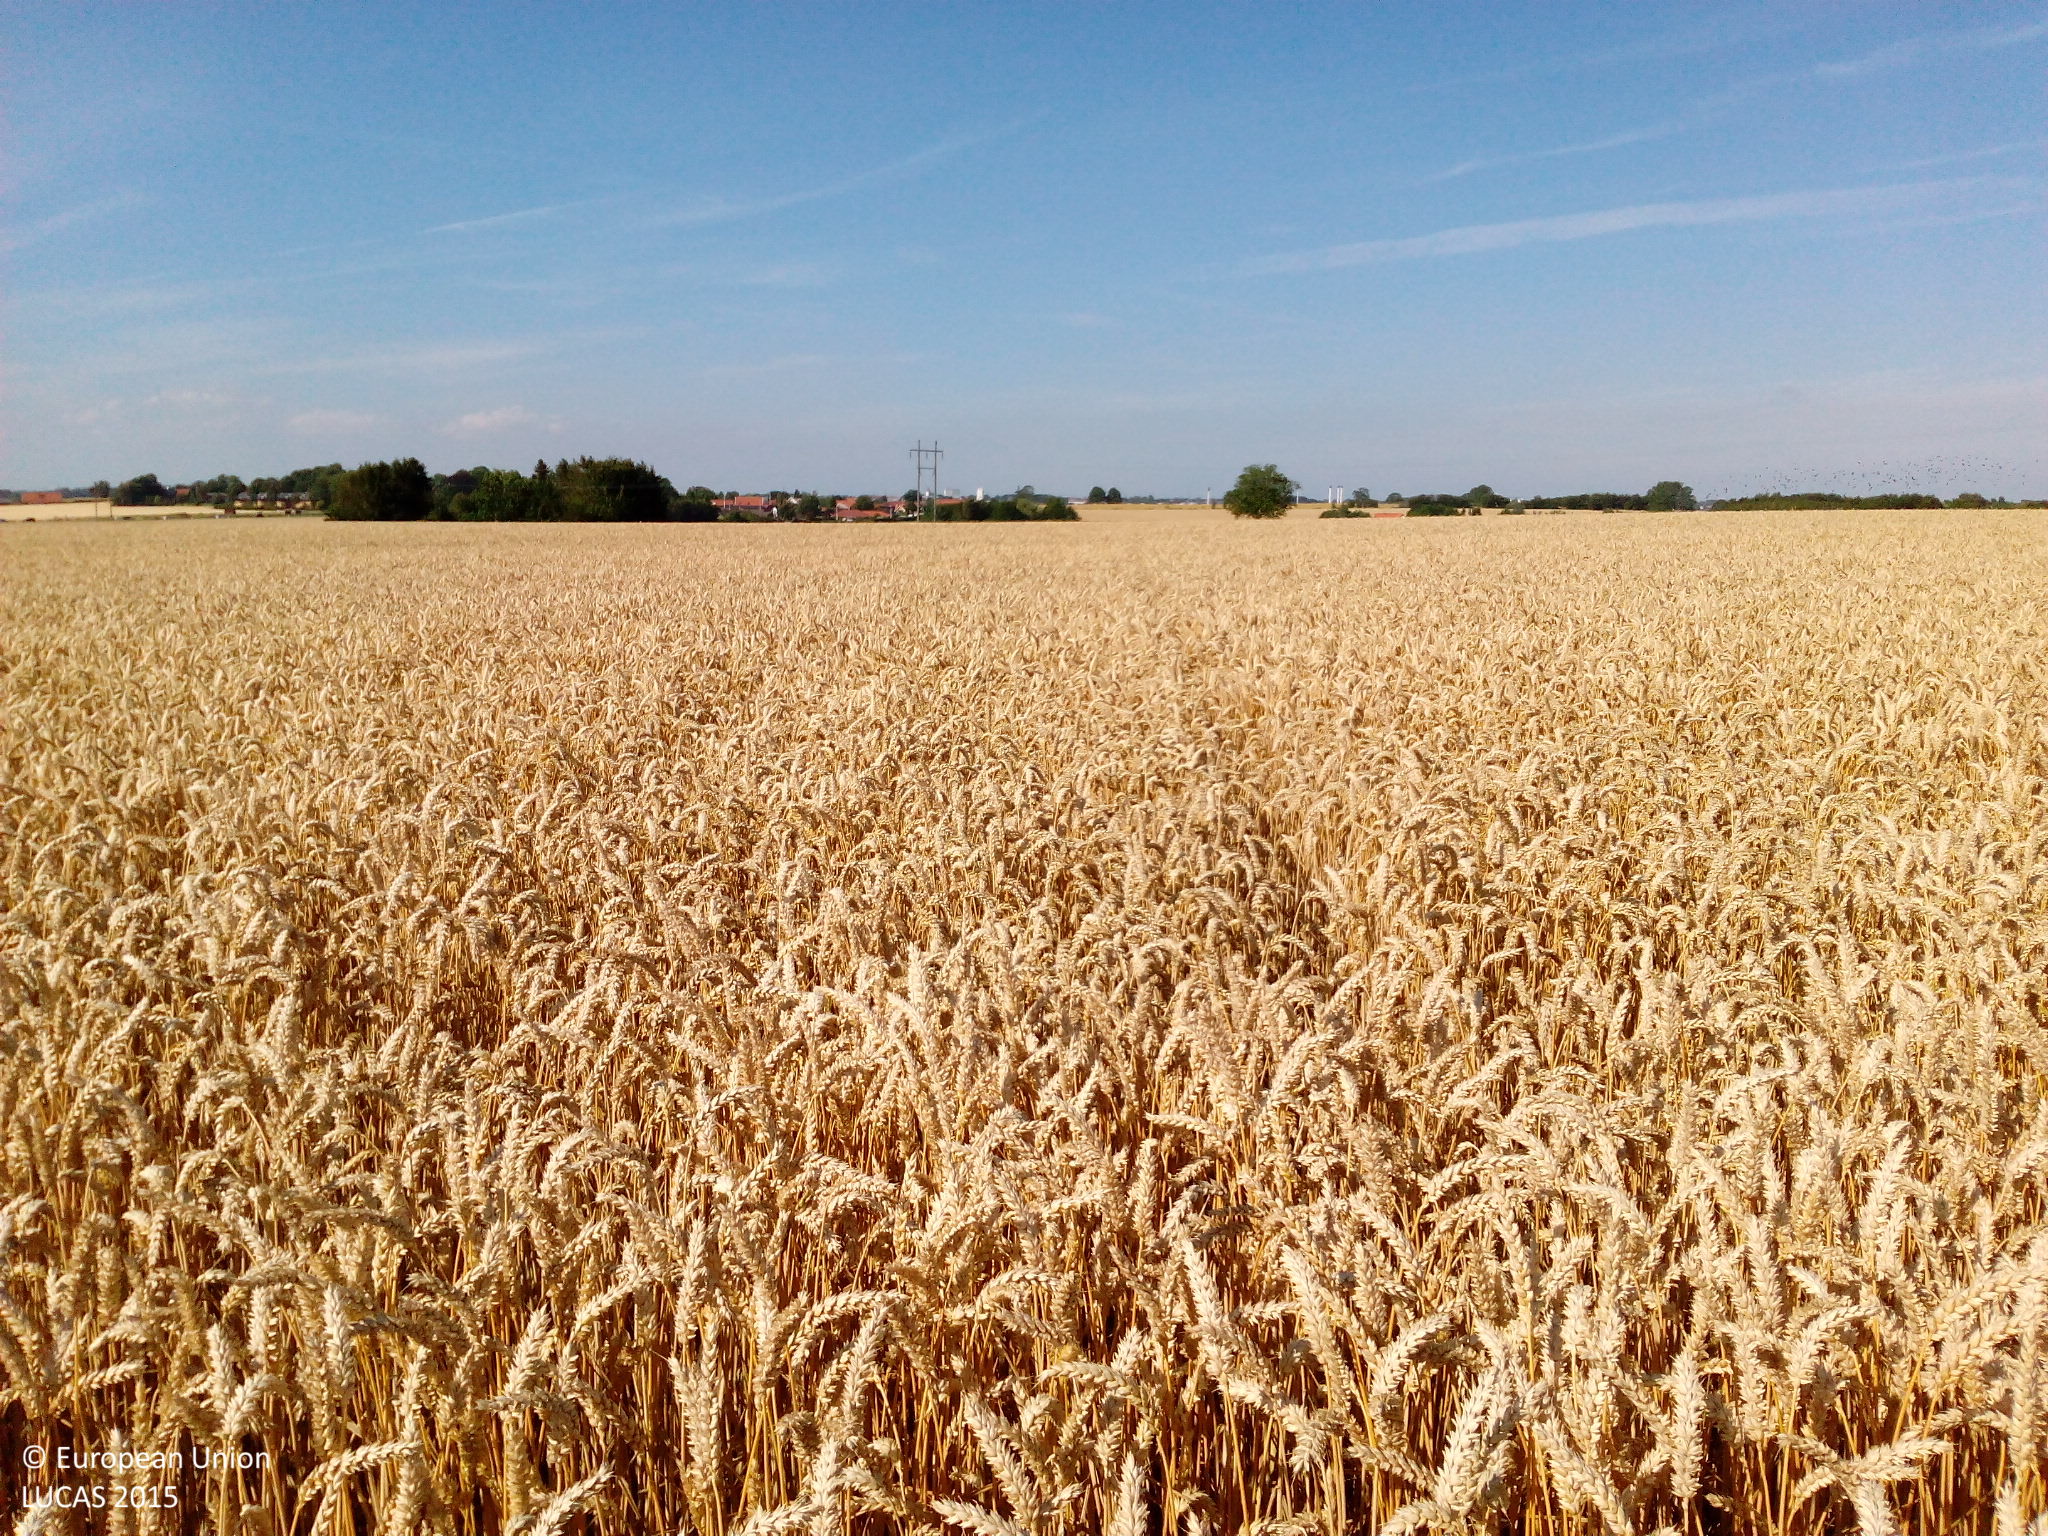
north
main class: Cropland
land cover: Common wheat
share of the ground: > 75 %
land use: Agriculture (excluding fallow land and kitchen gardens)
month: August
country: DK
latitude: 55.4023
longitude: 11.7830
